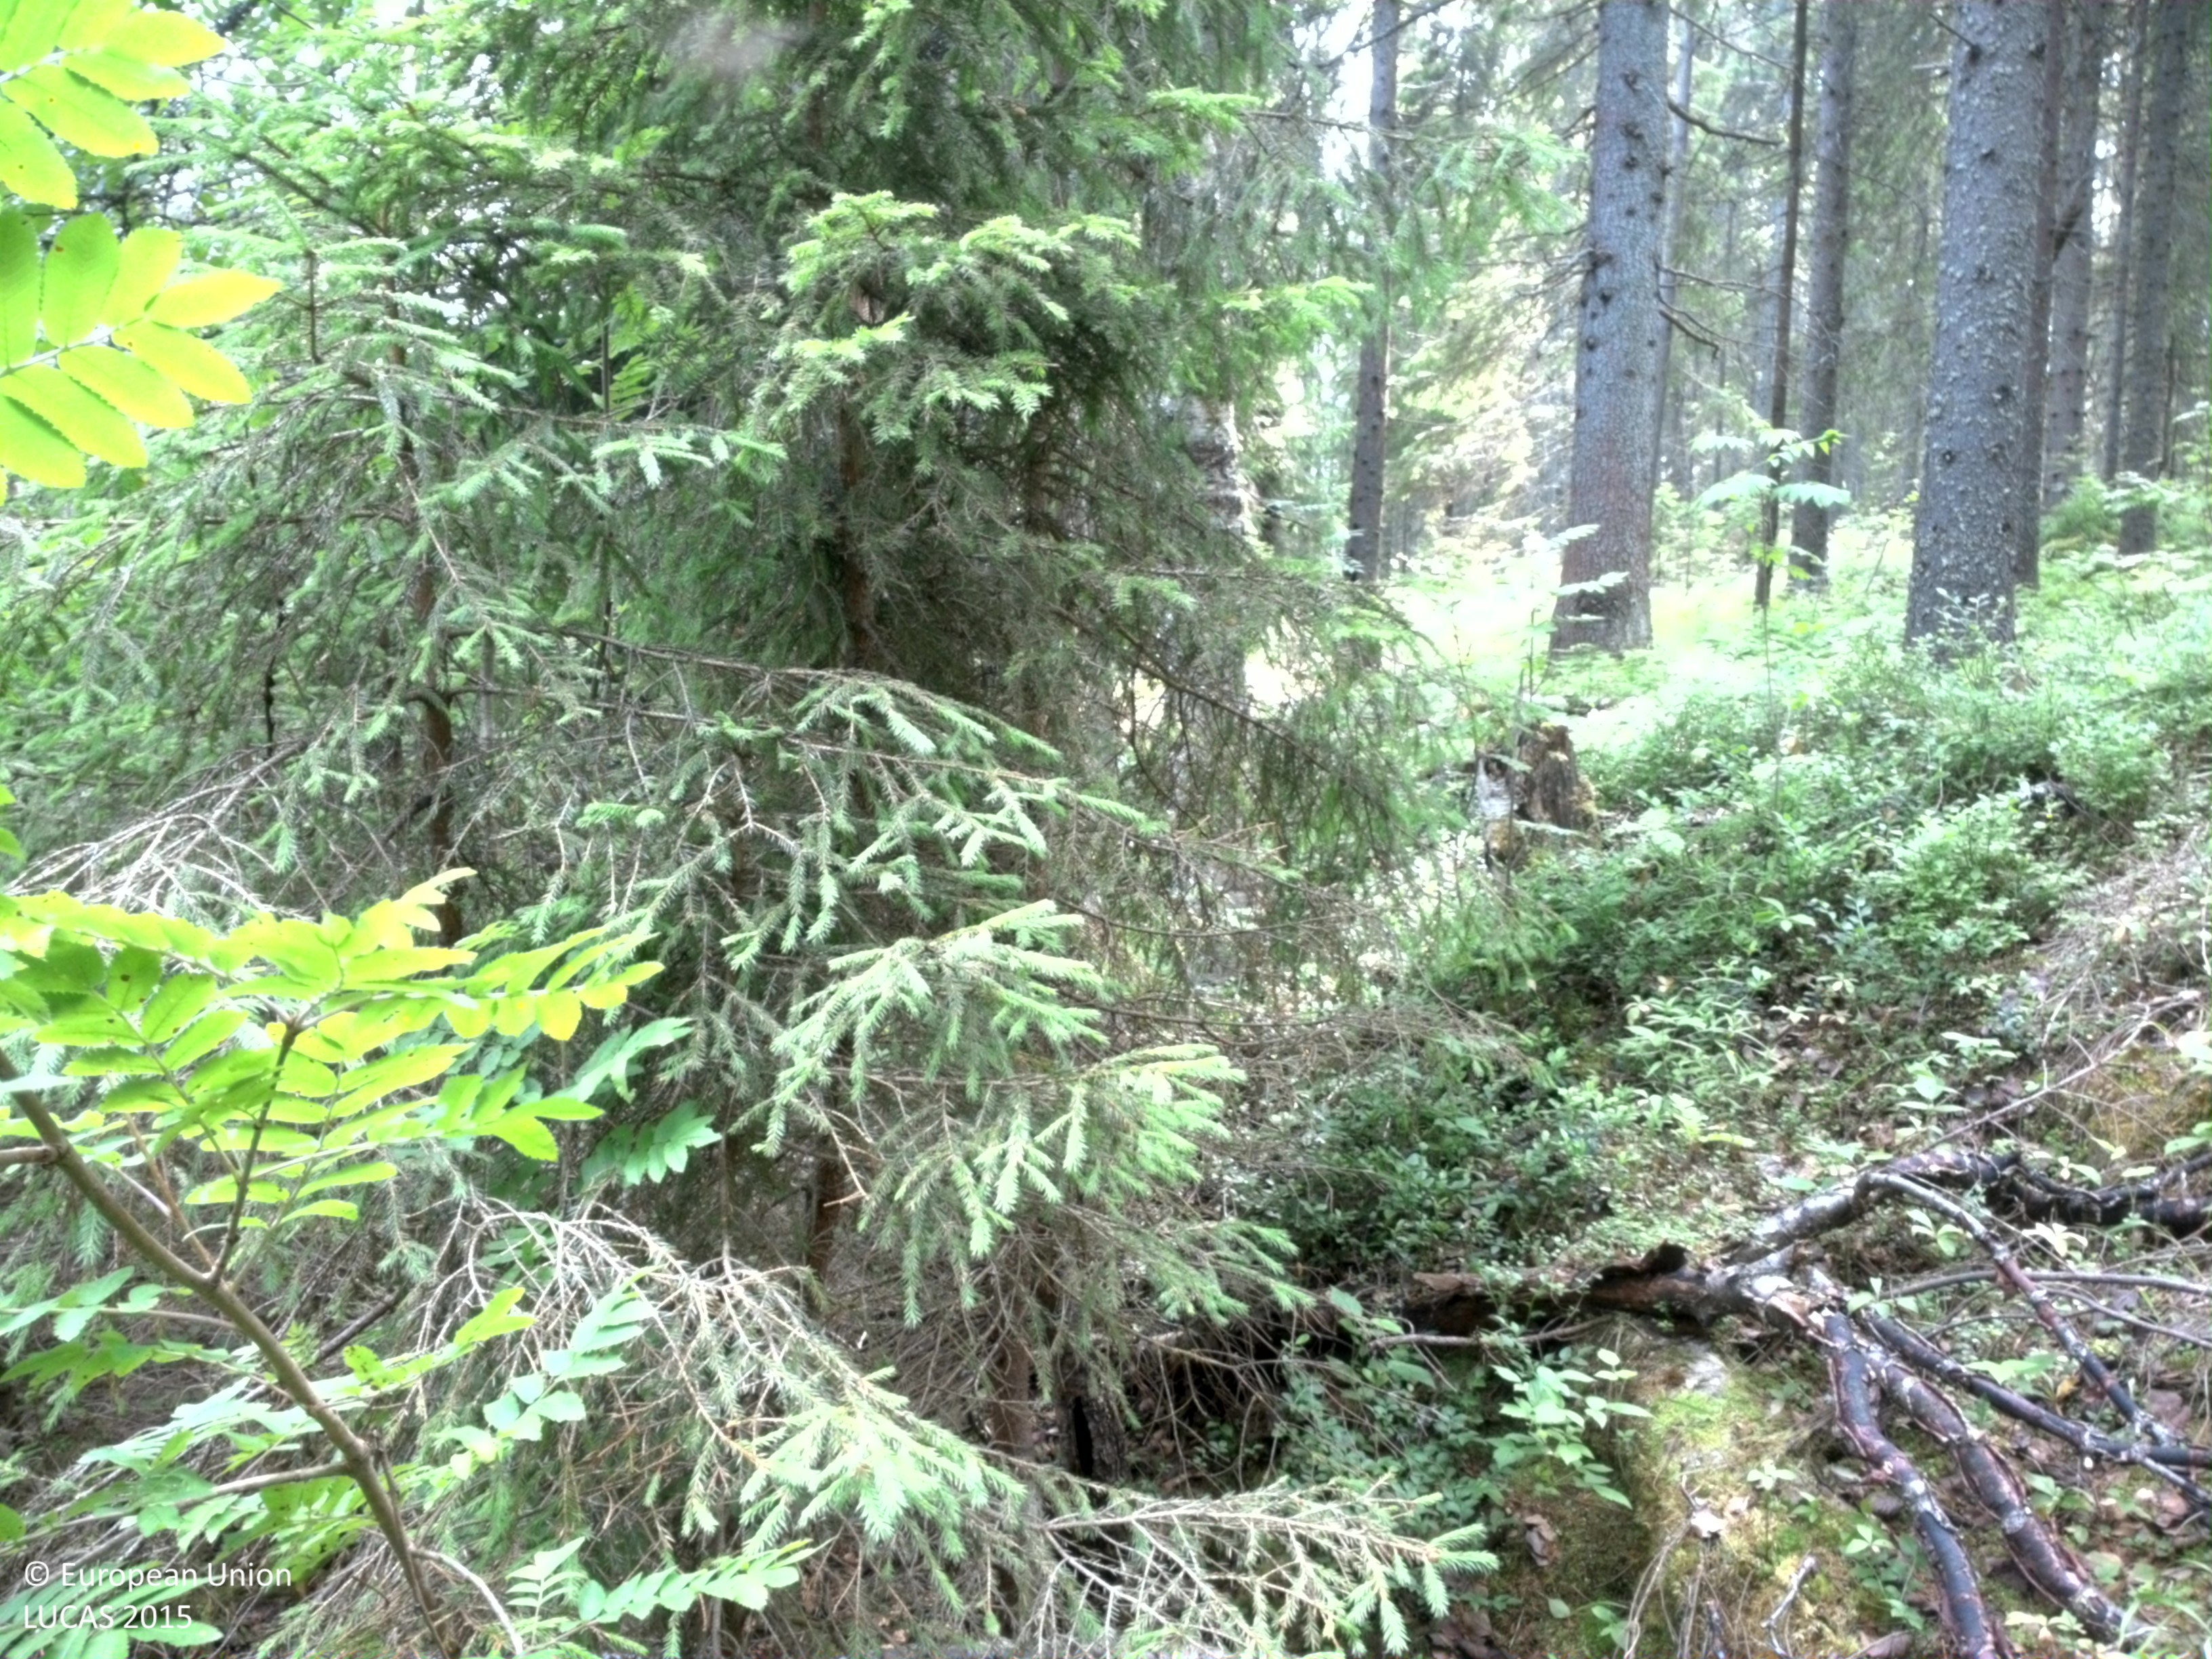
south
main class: Woodland
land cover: Spruce dominated coniferous woodland
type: boreal forest
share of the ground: 50 - 75 %
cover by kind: coniferous forest trees 70 %, shrubs 25 %, broadleaved forest trees 5 %
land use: Forestry
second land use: Amenities, museums, leisure
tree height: > 5 m
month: July
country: SE
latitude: 64.4350
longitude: 21.2614
